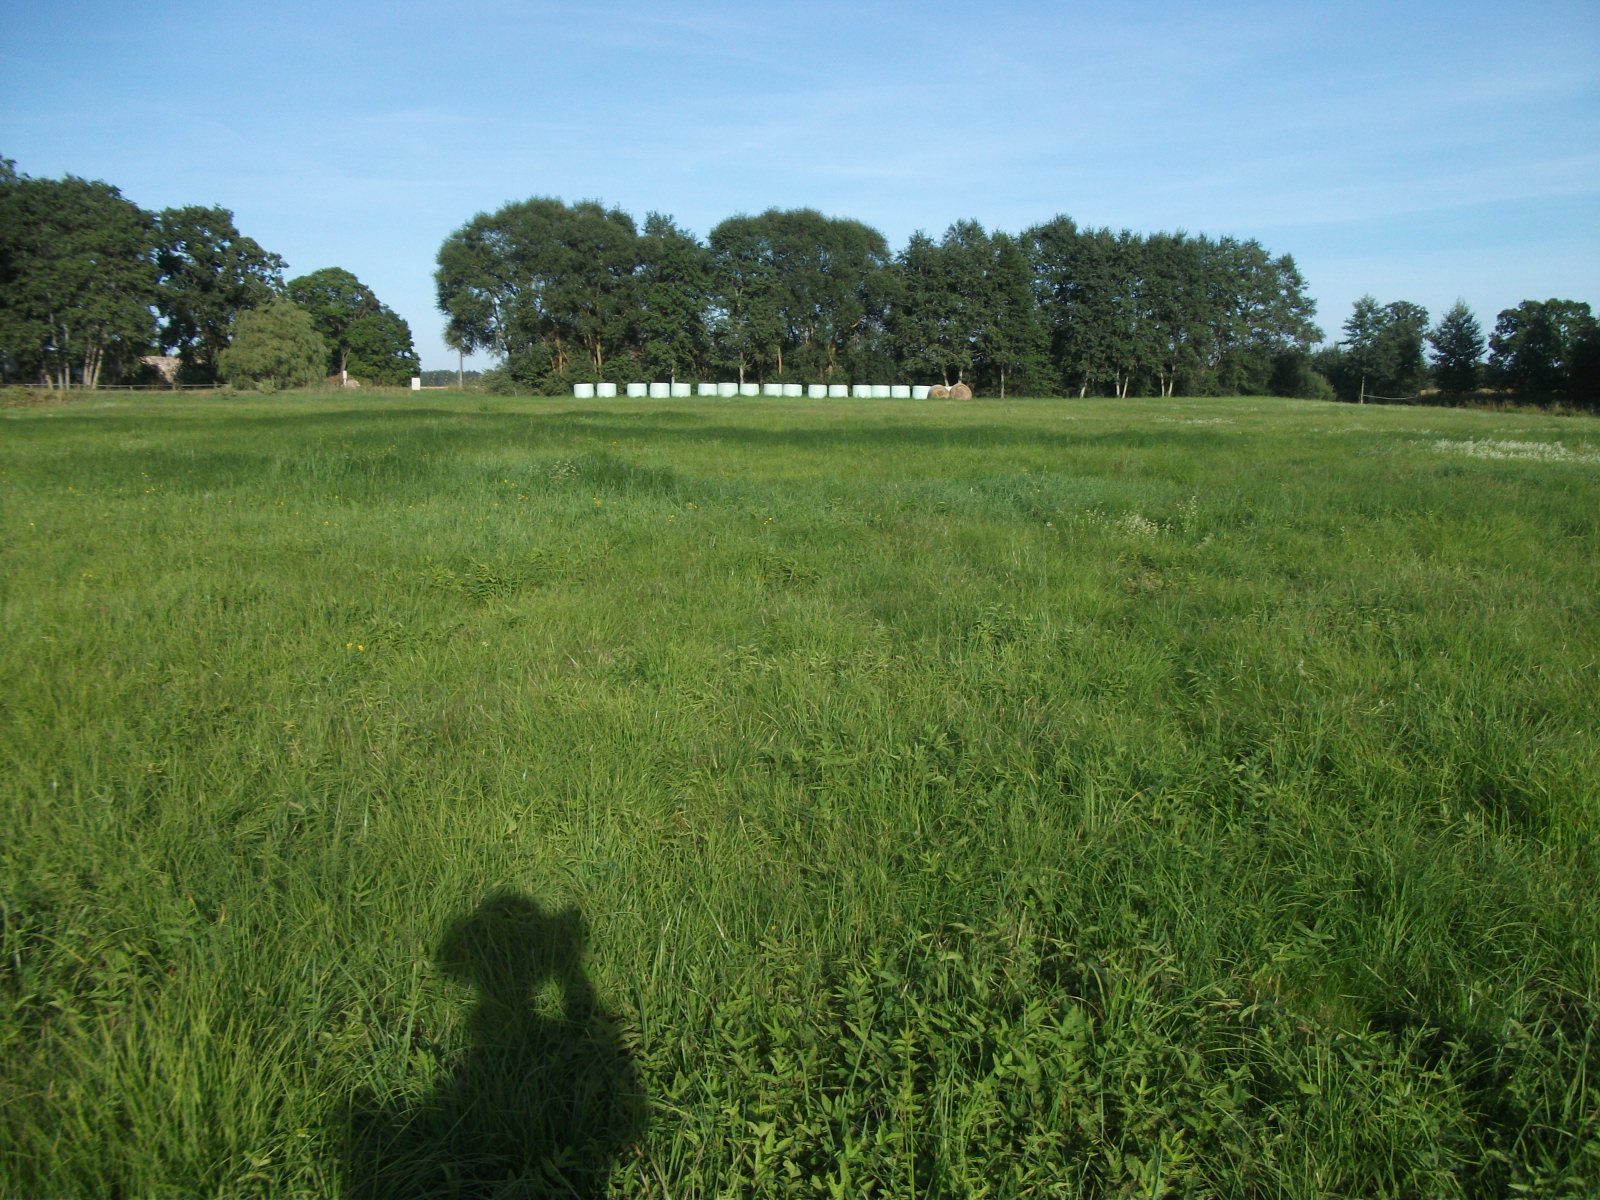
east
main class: Grassland
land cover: Grassland without tree/shrub cover
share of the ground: > 75 %
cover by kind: herbaceous plants 100 %
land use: Agriculture (excluding fallow land and kitchen gardens)
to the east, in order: Grassland without tree/shrub cover; Ditches and canals; Broadleaved woodland; Grassland without tree/shrub cover; Electric lines; Grassland without tree/shrub cover
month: August
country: LV
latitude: 56.3774
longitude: 26.2200
